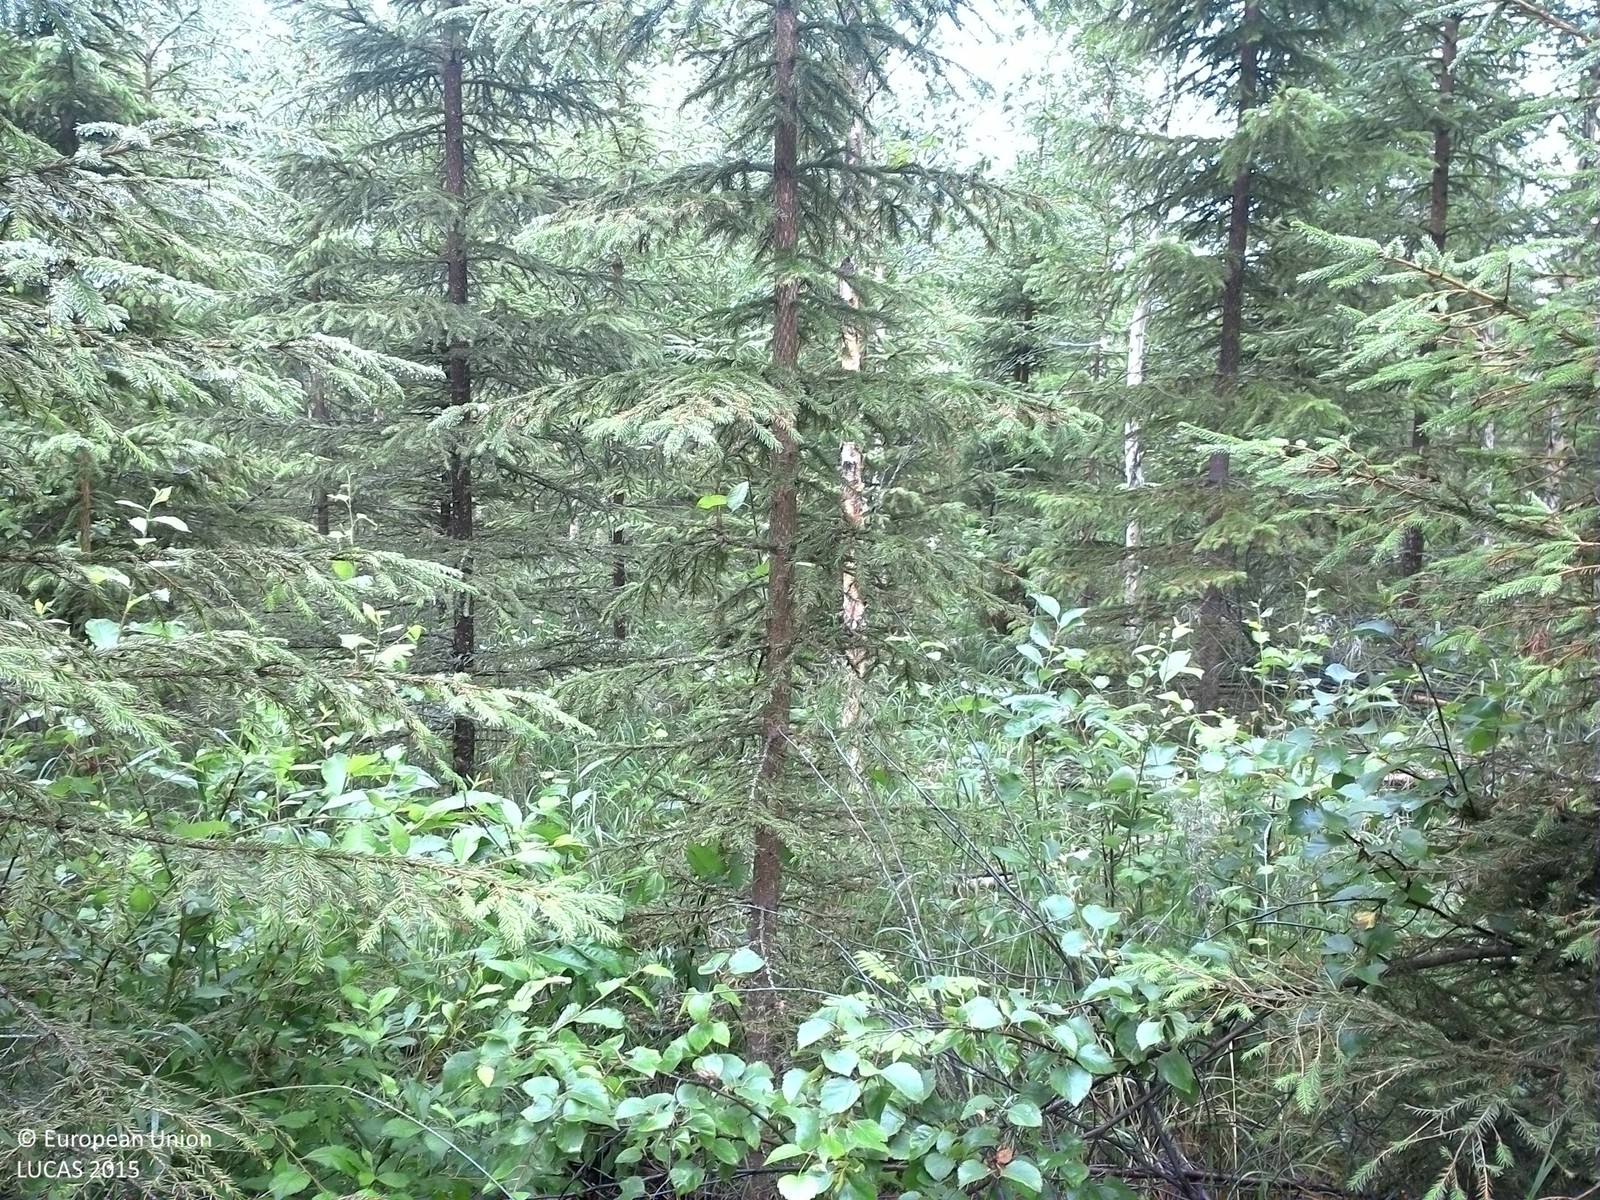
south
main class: Woodland
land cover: Spruce dominated mixed woodland
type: boreal forest
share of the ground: 50 - 75 %
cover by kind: coniferous forest trees 35 %, broadleaved forest trees 35 %, herbaceous plants 25 %, lichens and mosses 5 %
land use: Forestry
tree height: > 5 m
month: August
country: SE
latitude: 63.5643
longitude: 16.3557
